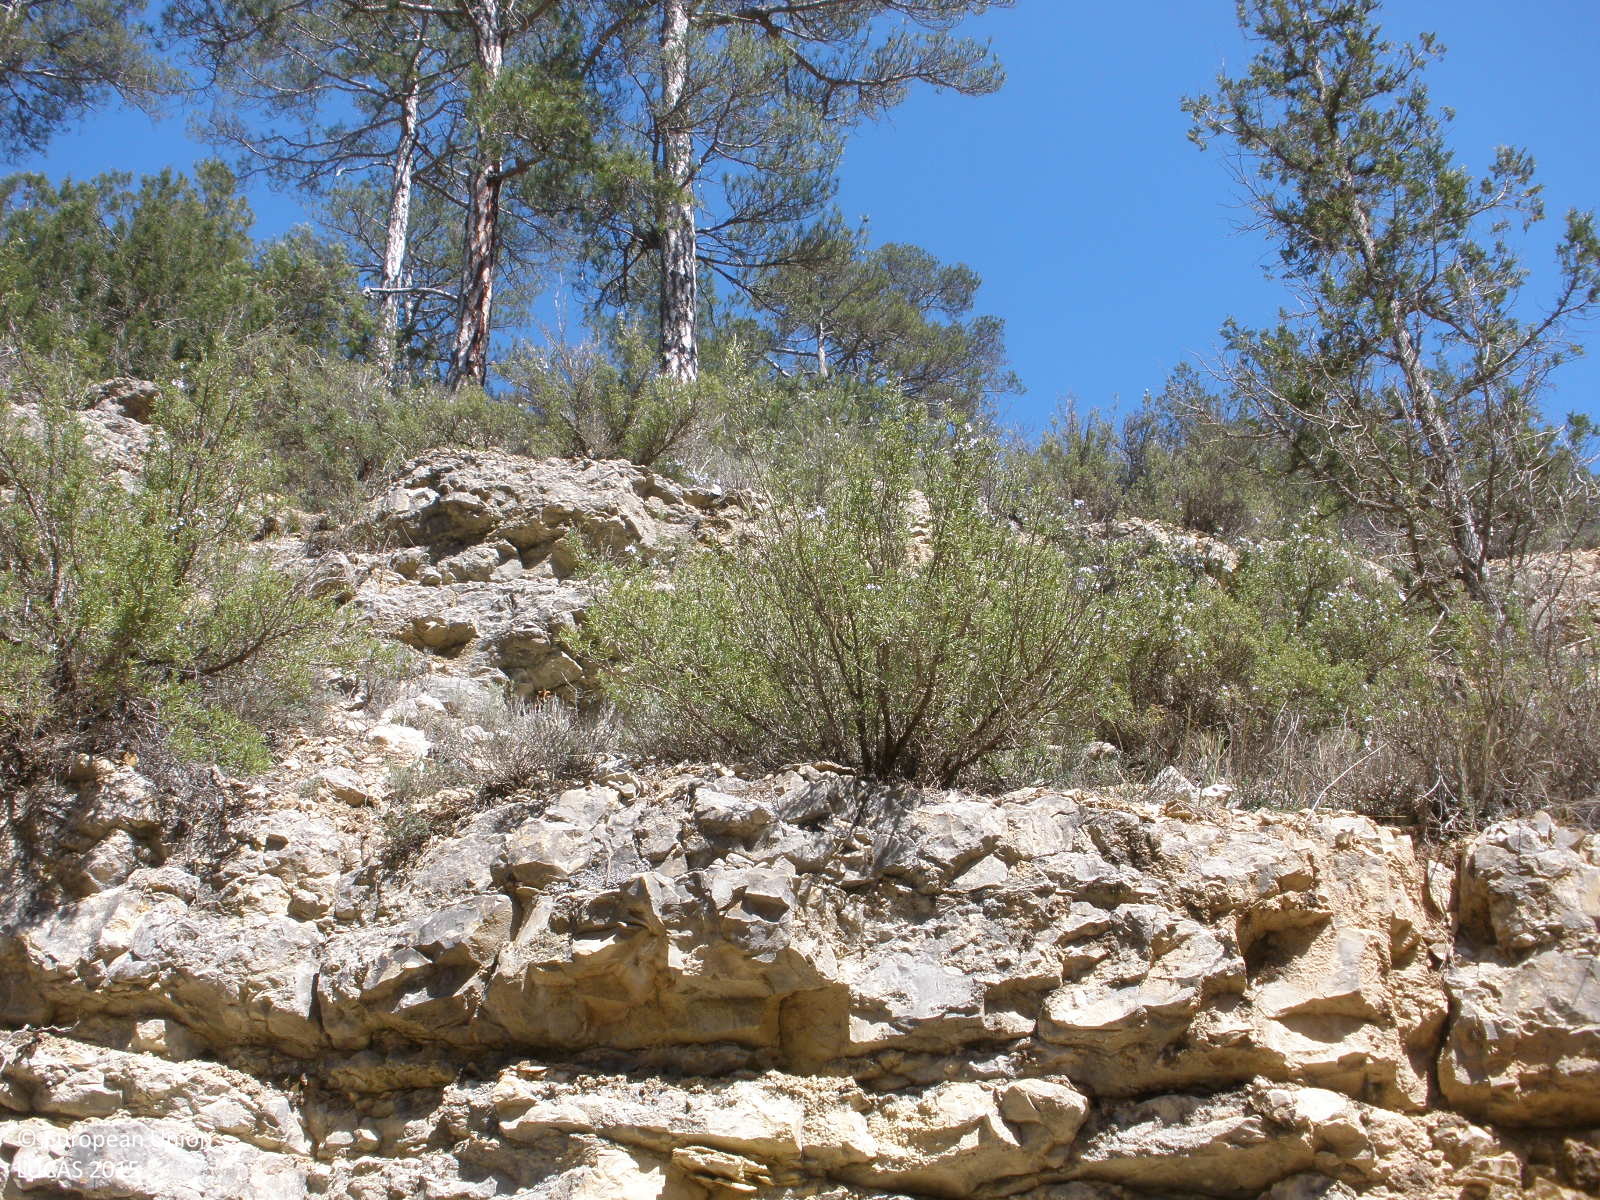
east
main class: Woodland
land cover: Pine dominated coniferous woodland
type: coniferous forest of the mediterranean region
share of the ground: 25 - 50 %
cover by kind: coniferous forest trees 40 %, shrubs 40 %, consolidated bare surface 20 %
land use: Semi-natural and natural areas not in use
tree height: > 5 m
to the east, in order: Pine dominated coniferous woodland; Other structural elements; Pine dominated coniferous woodland
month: April
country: ES
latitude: 40.2760
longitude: -1.2424
